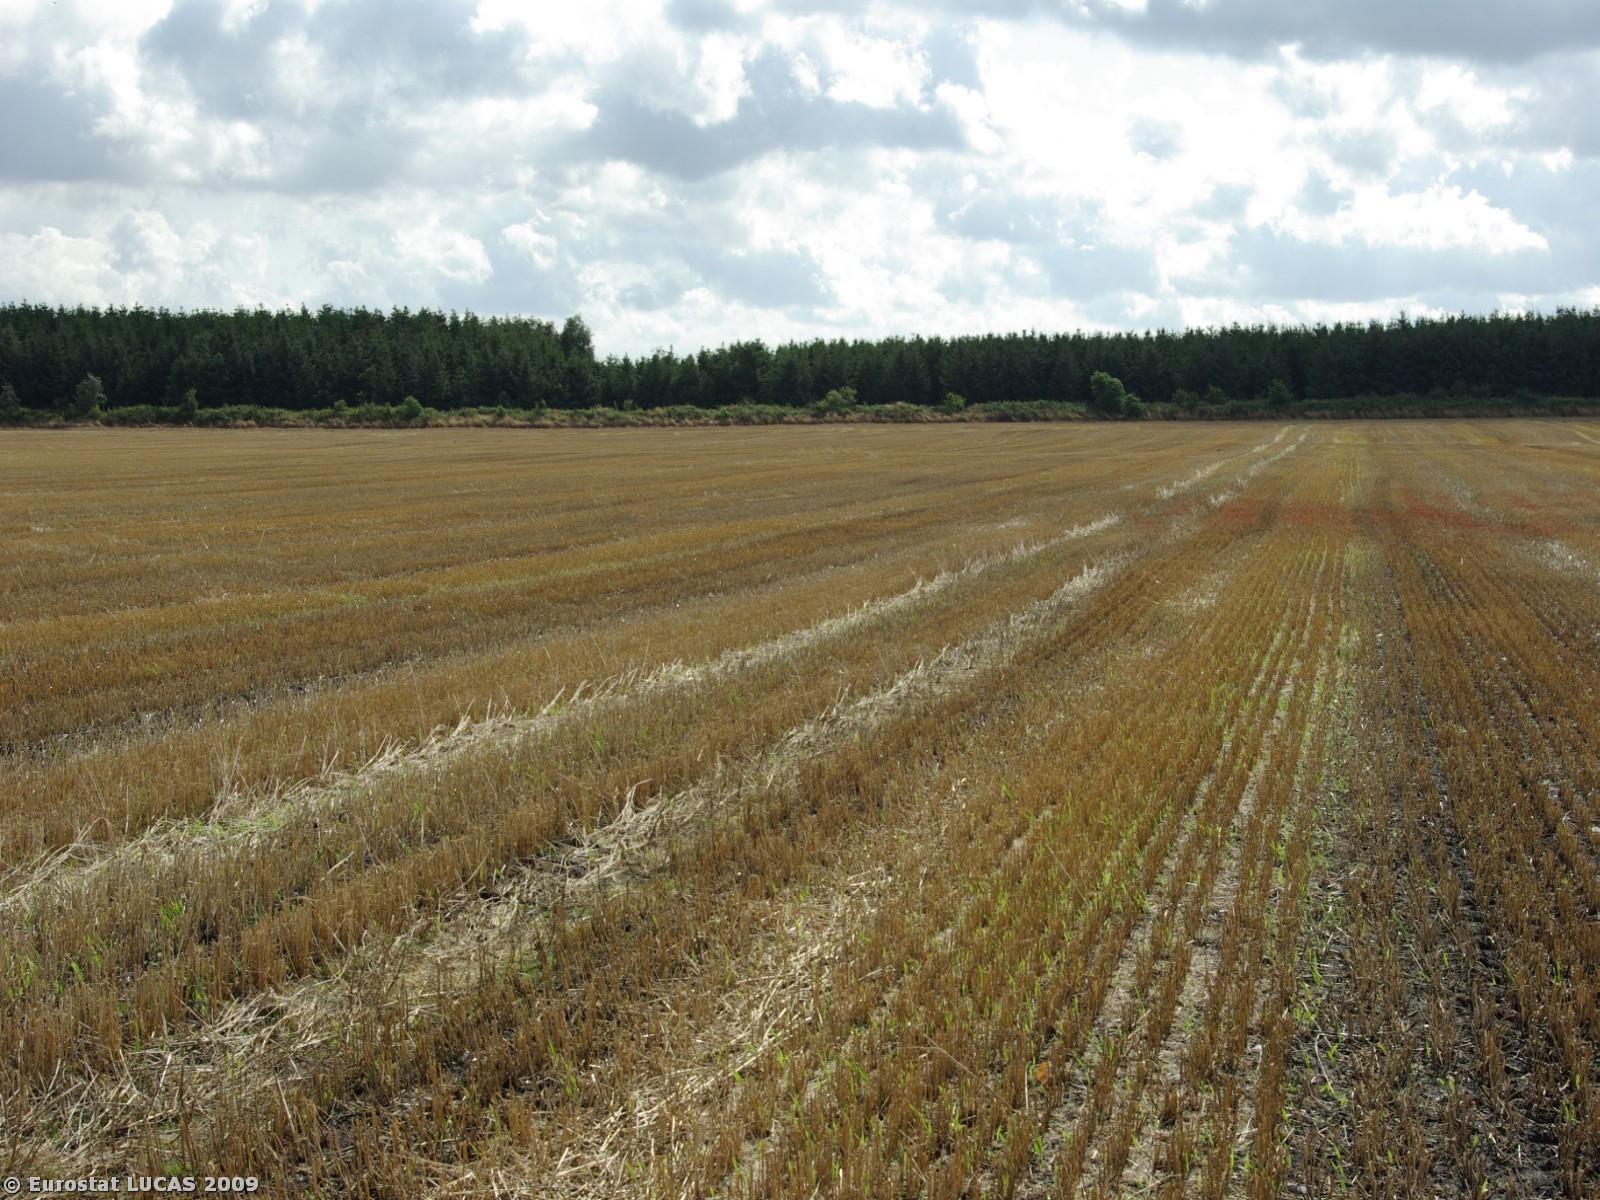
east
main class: Cropland
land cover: Barley
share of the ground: < 10 %
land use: Agriculture (excluding fallow land and kitchen gardens)
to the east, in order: Barley
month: July
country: DK
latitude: 55.1433
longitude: 9.2946
